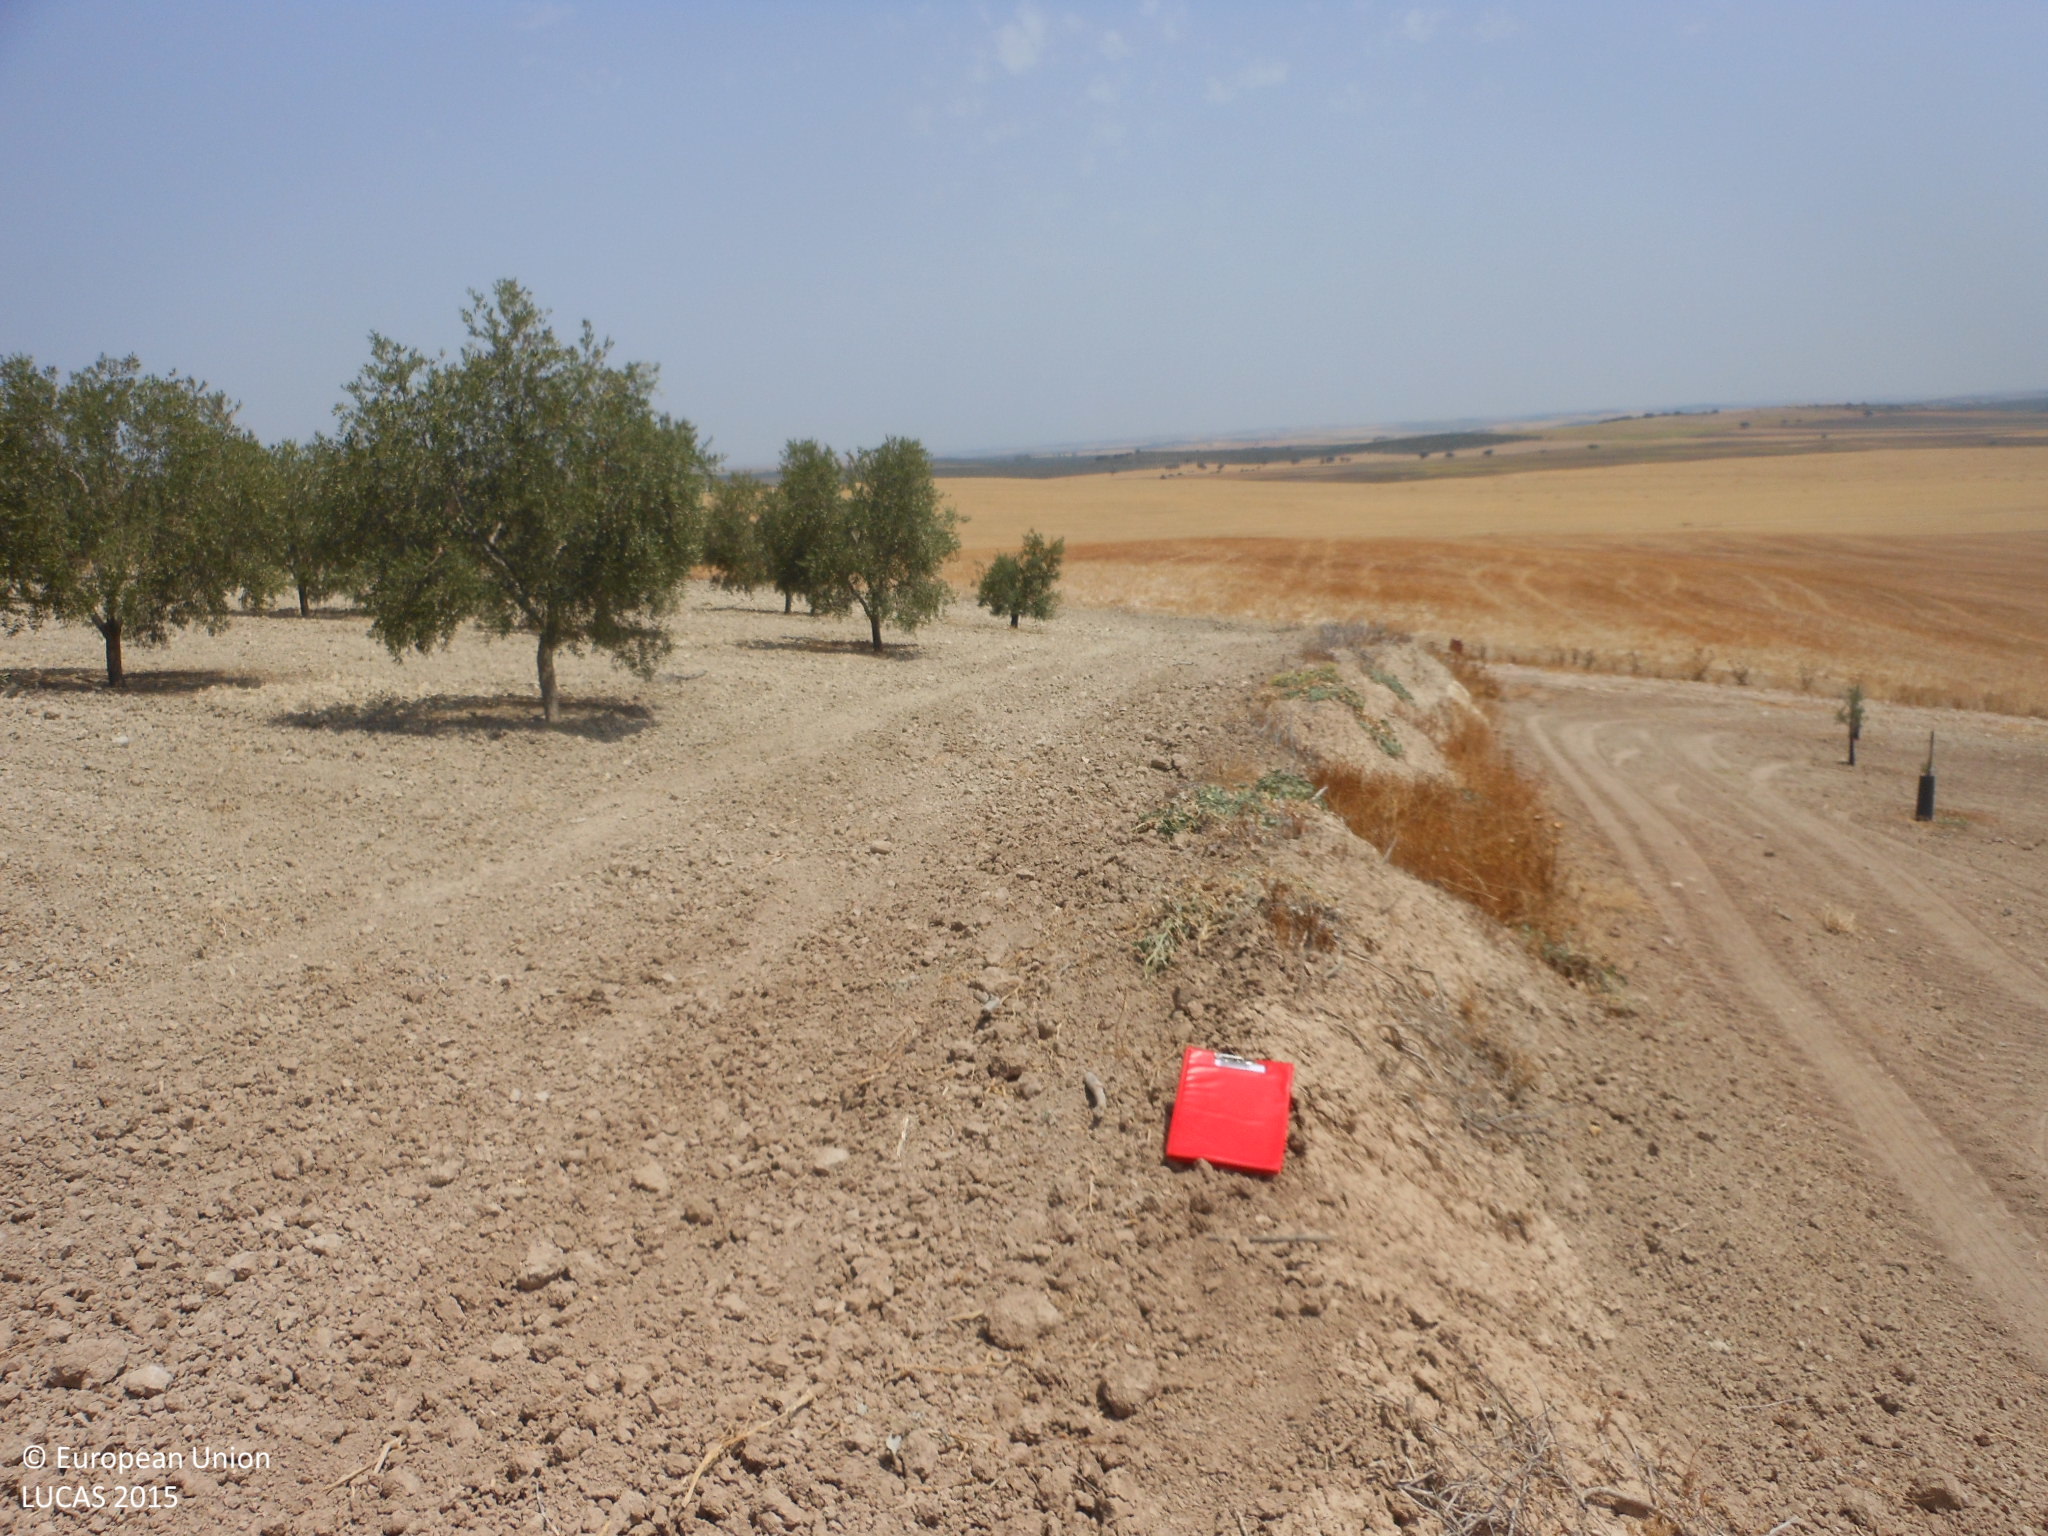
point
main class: Cropland
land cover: Olive groves
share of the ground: 25 - 50 %
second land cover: Other bare soil
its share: > 75 %
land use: Agriculture (excluding fallow land and kitchen gardens)
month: July
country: ES
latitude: 37.3866
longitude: -5.0652
